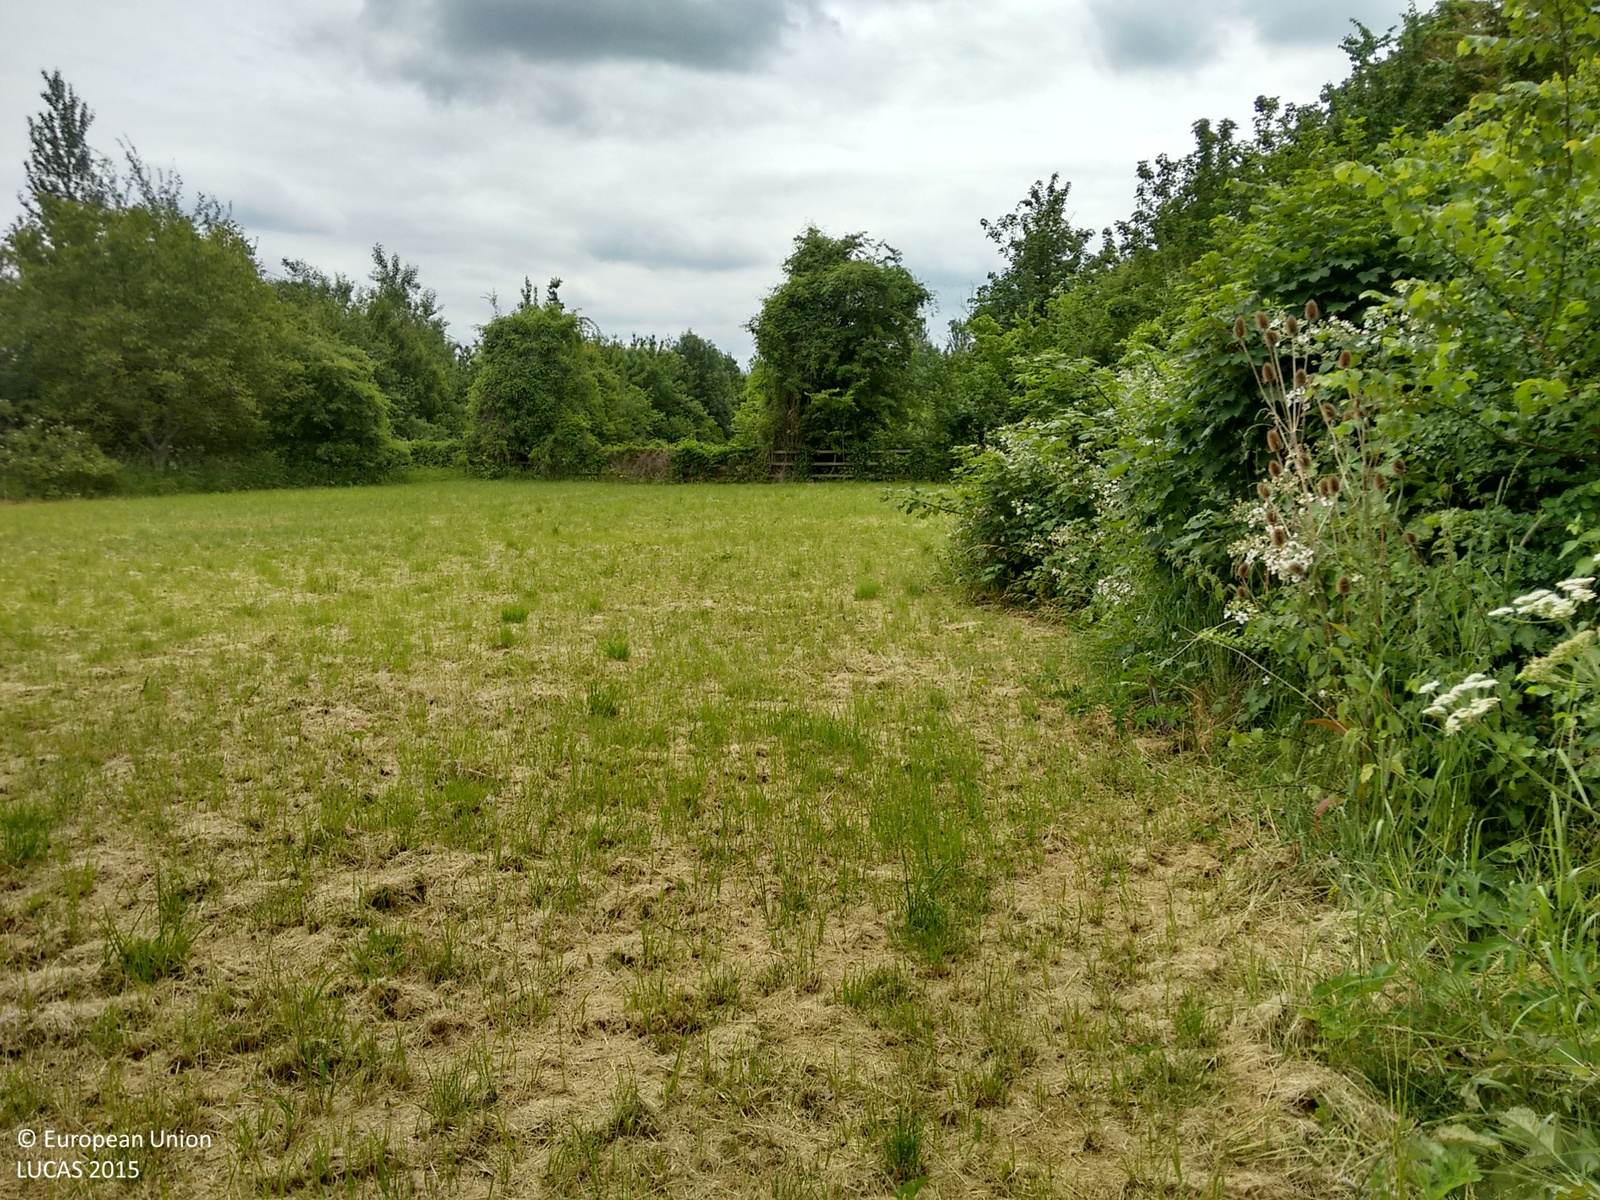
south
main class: Woodland
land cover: Broadleaved woodland
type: mesophytic deciduous forest
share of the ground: > 75 %
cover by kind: broadleaved forest trees 60 %, herbaceous plants 40 %
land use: Semi-natural and natural areas not in use
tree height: > 5 m
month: June
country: GB
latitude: 51.6386
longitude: -1.2753
